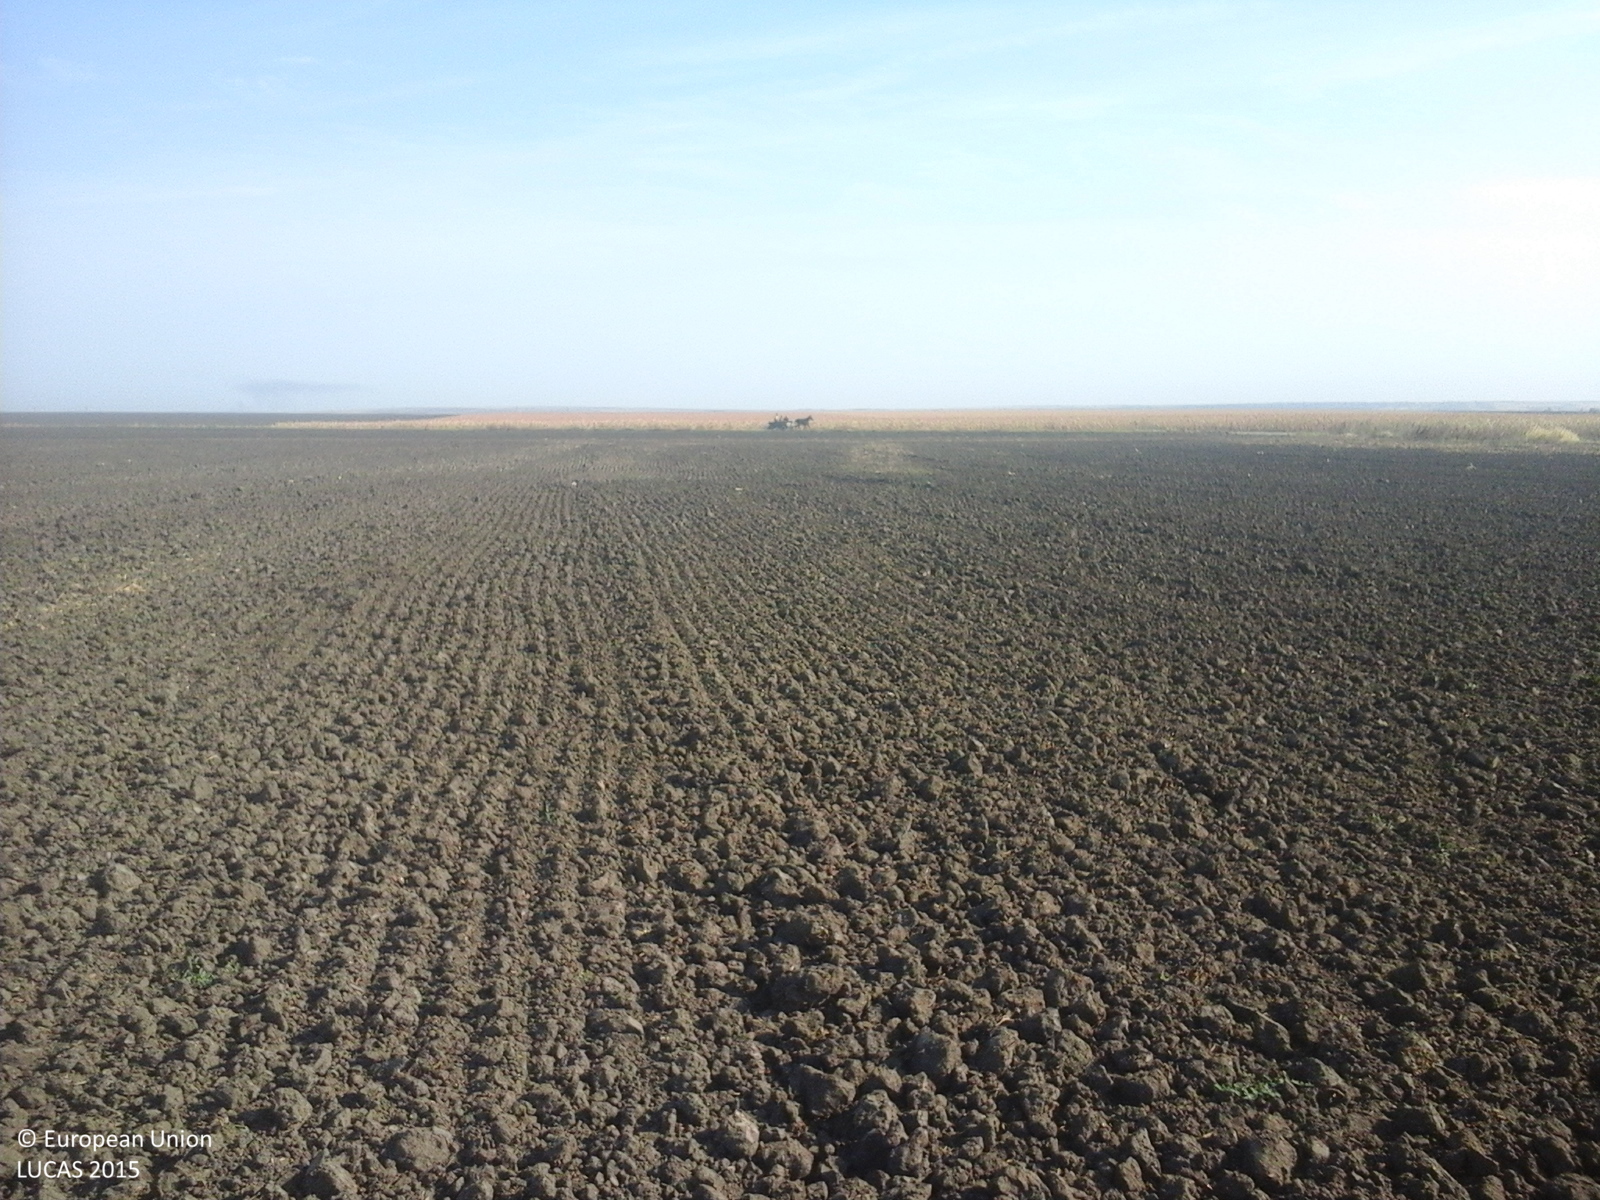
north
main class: Cropland
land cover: Barley
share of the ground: < 10 %
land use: Agriculture (excluding fallow land and kitchen gardens)
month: August
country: RO
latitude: 44.2016
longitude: 23.0197
